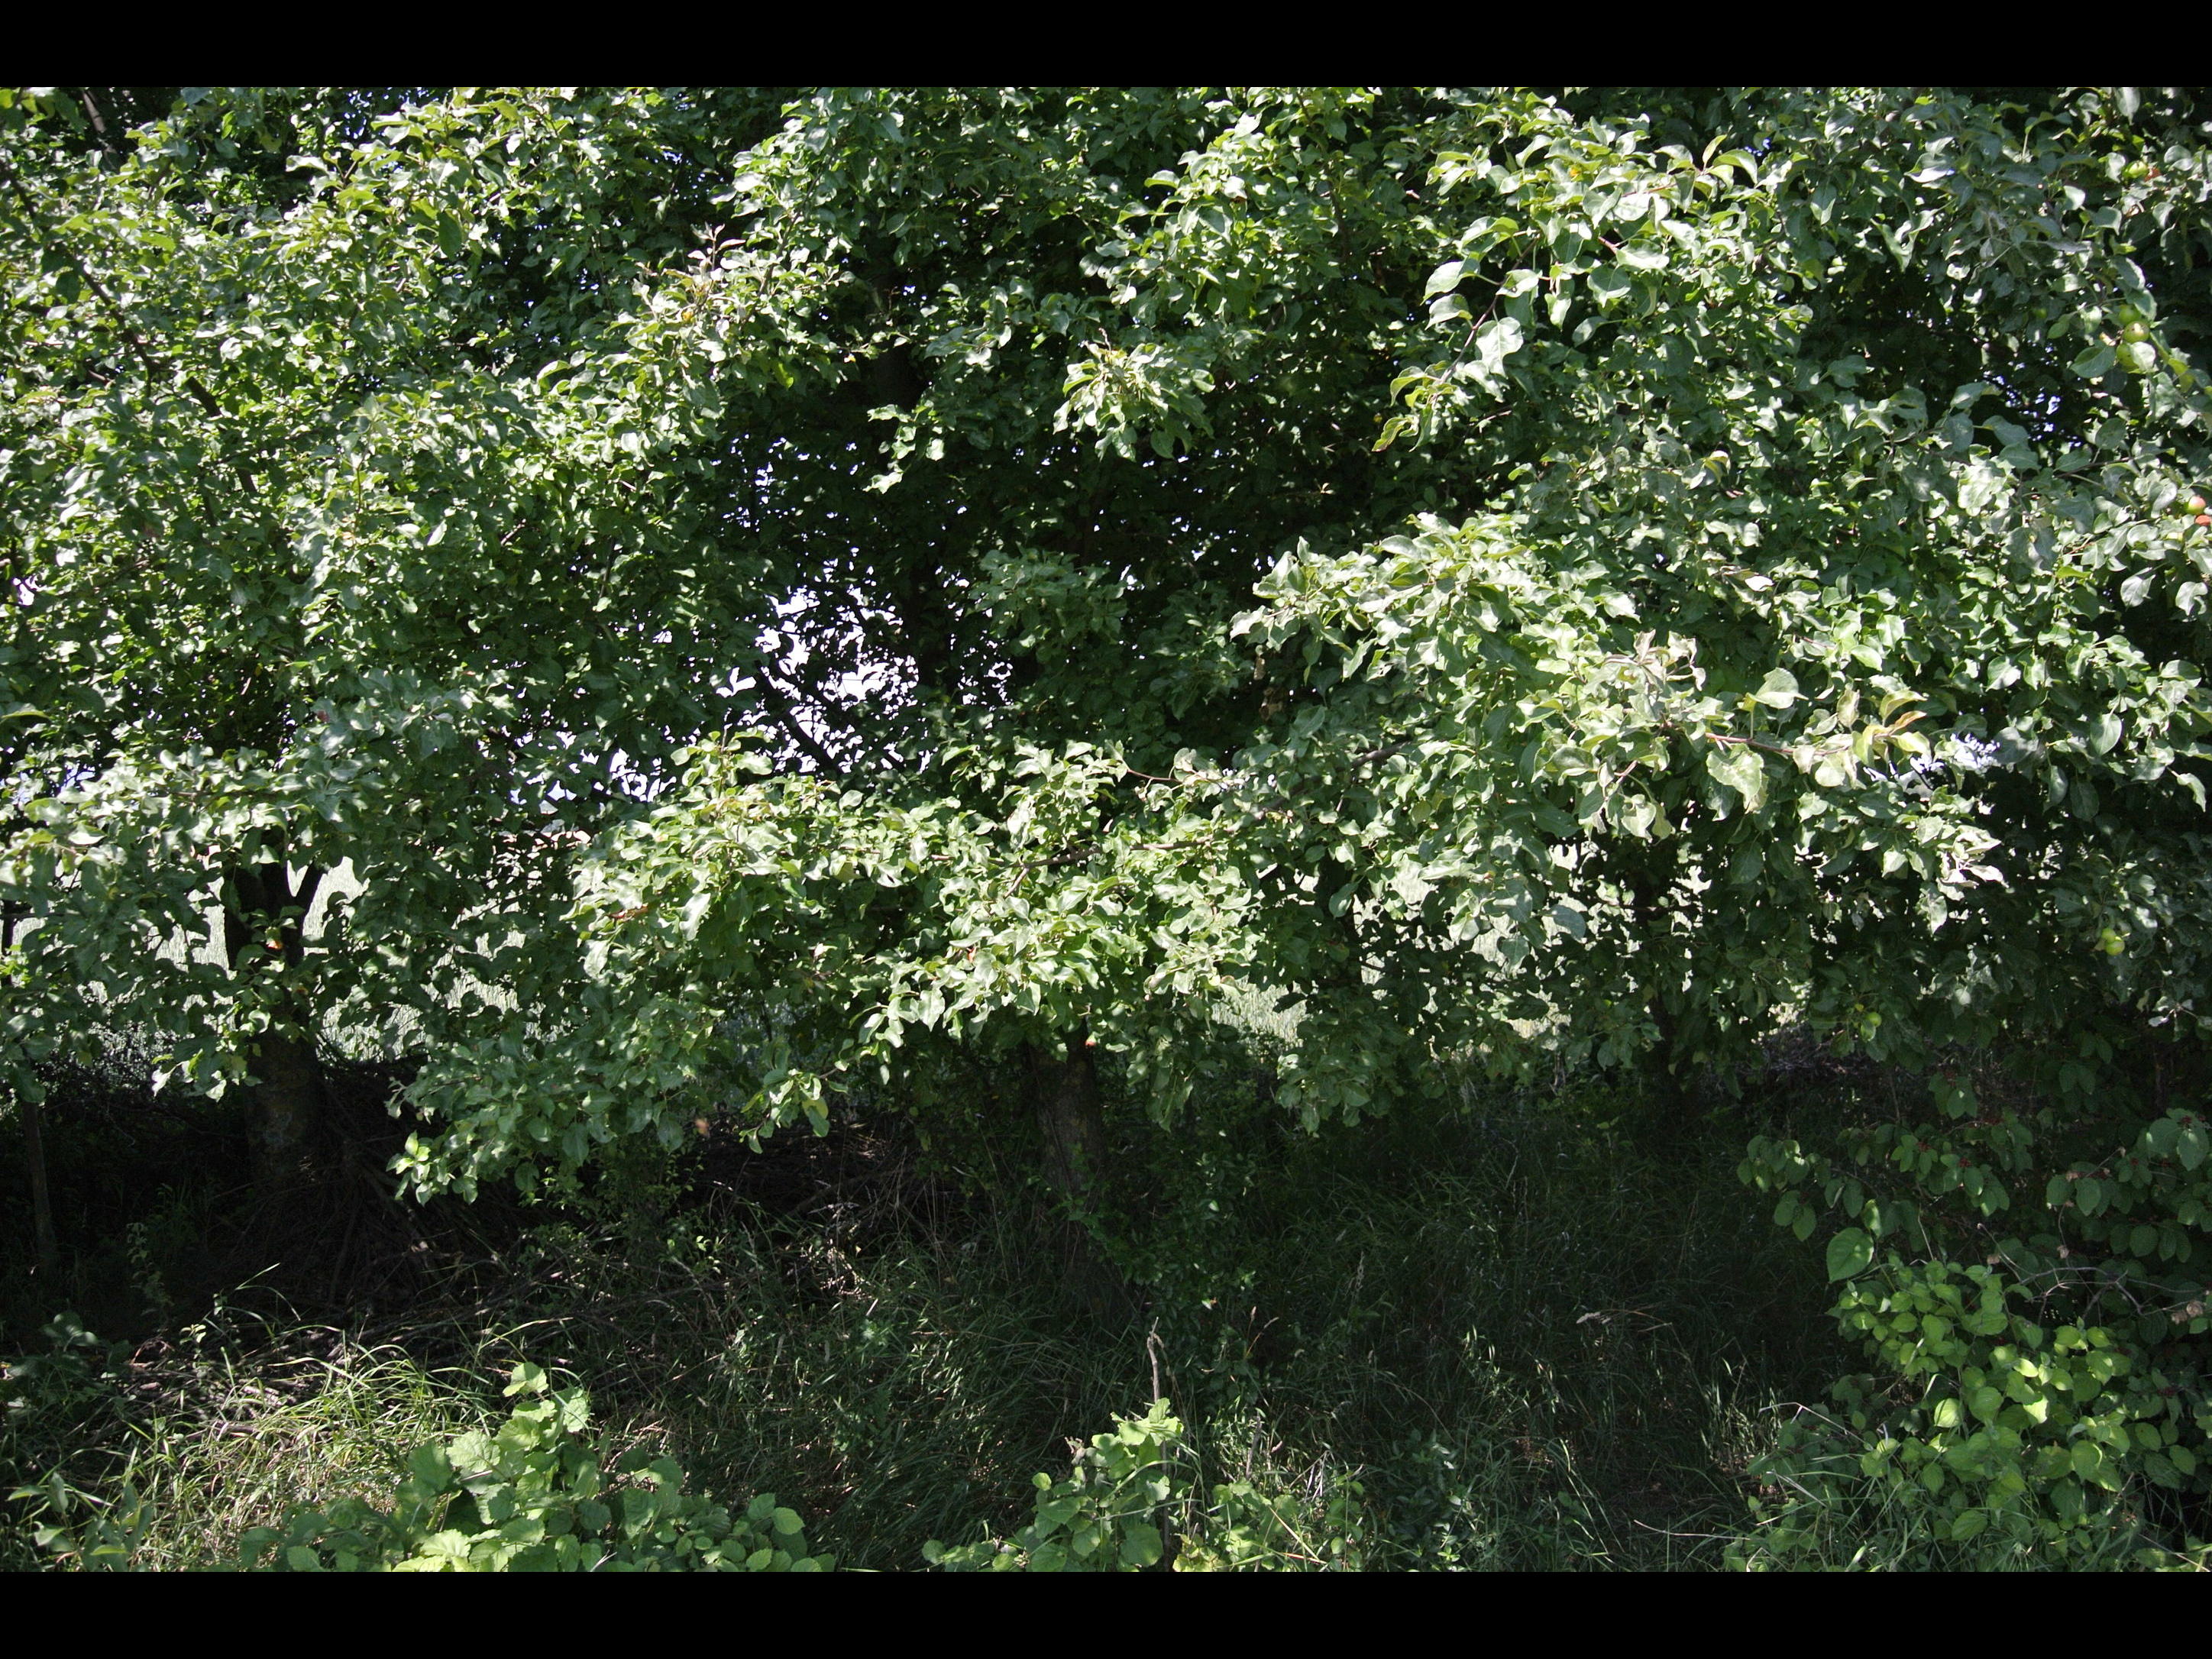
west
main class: Cropland
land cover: Lucerne
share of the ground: > 75 %
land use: Agriculture (excluding fallow land and kitchen gardens)
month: June
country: AT
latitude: 47.7982
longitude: 16.4796
